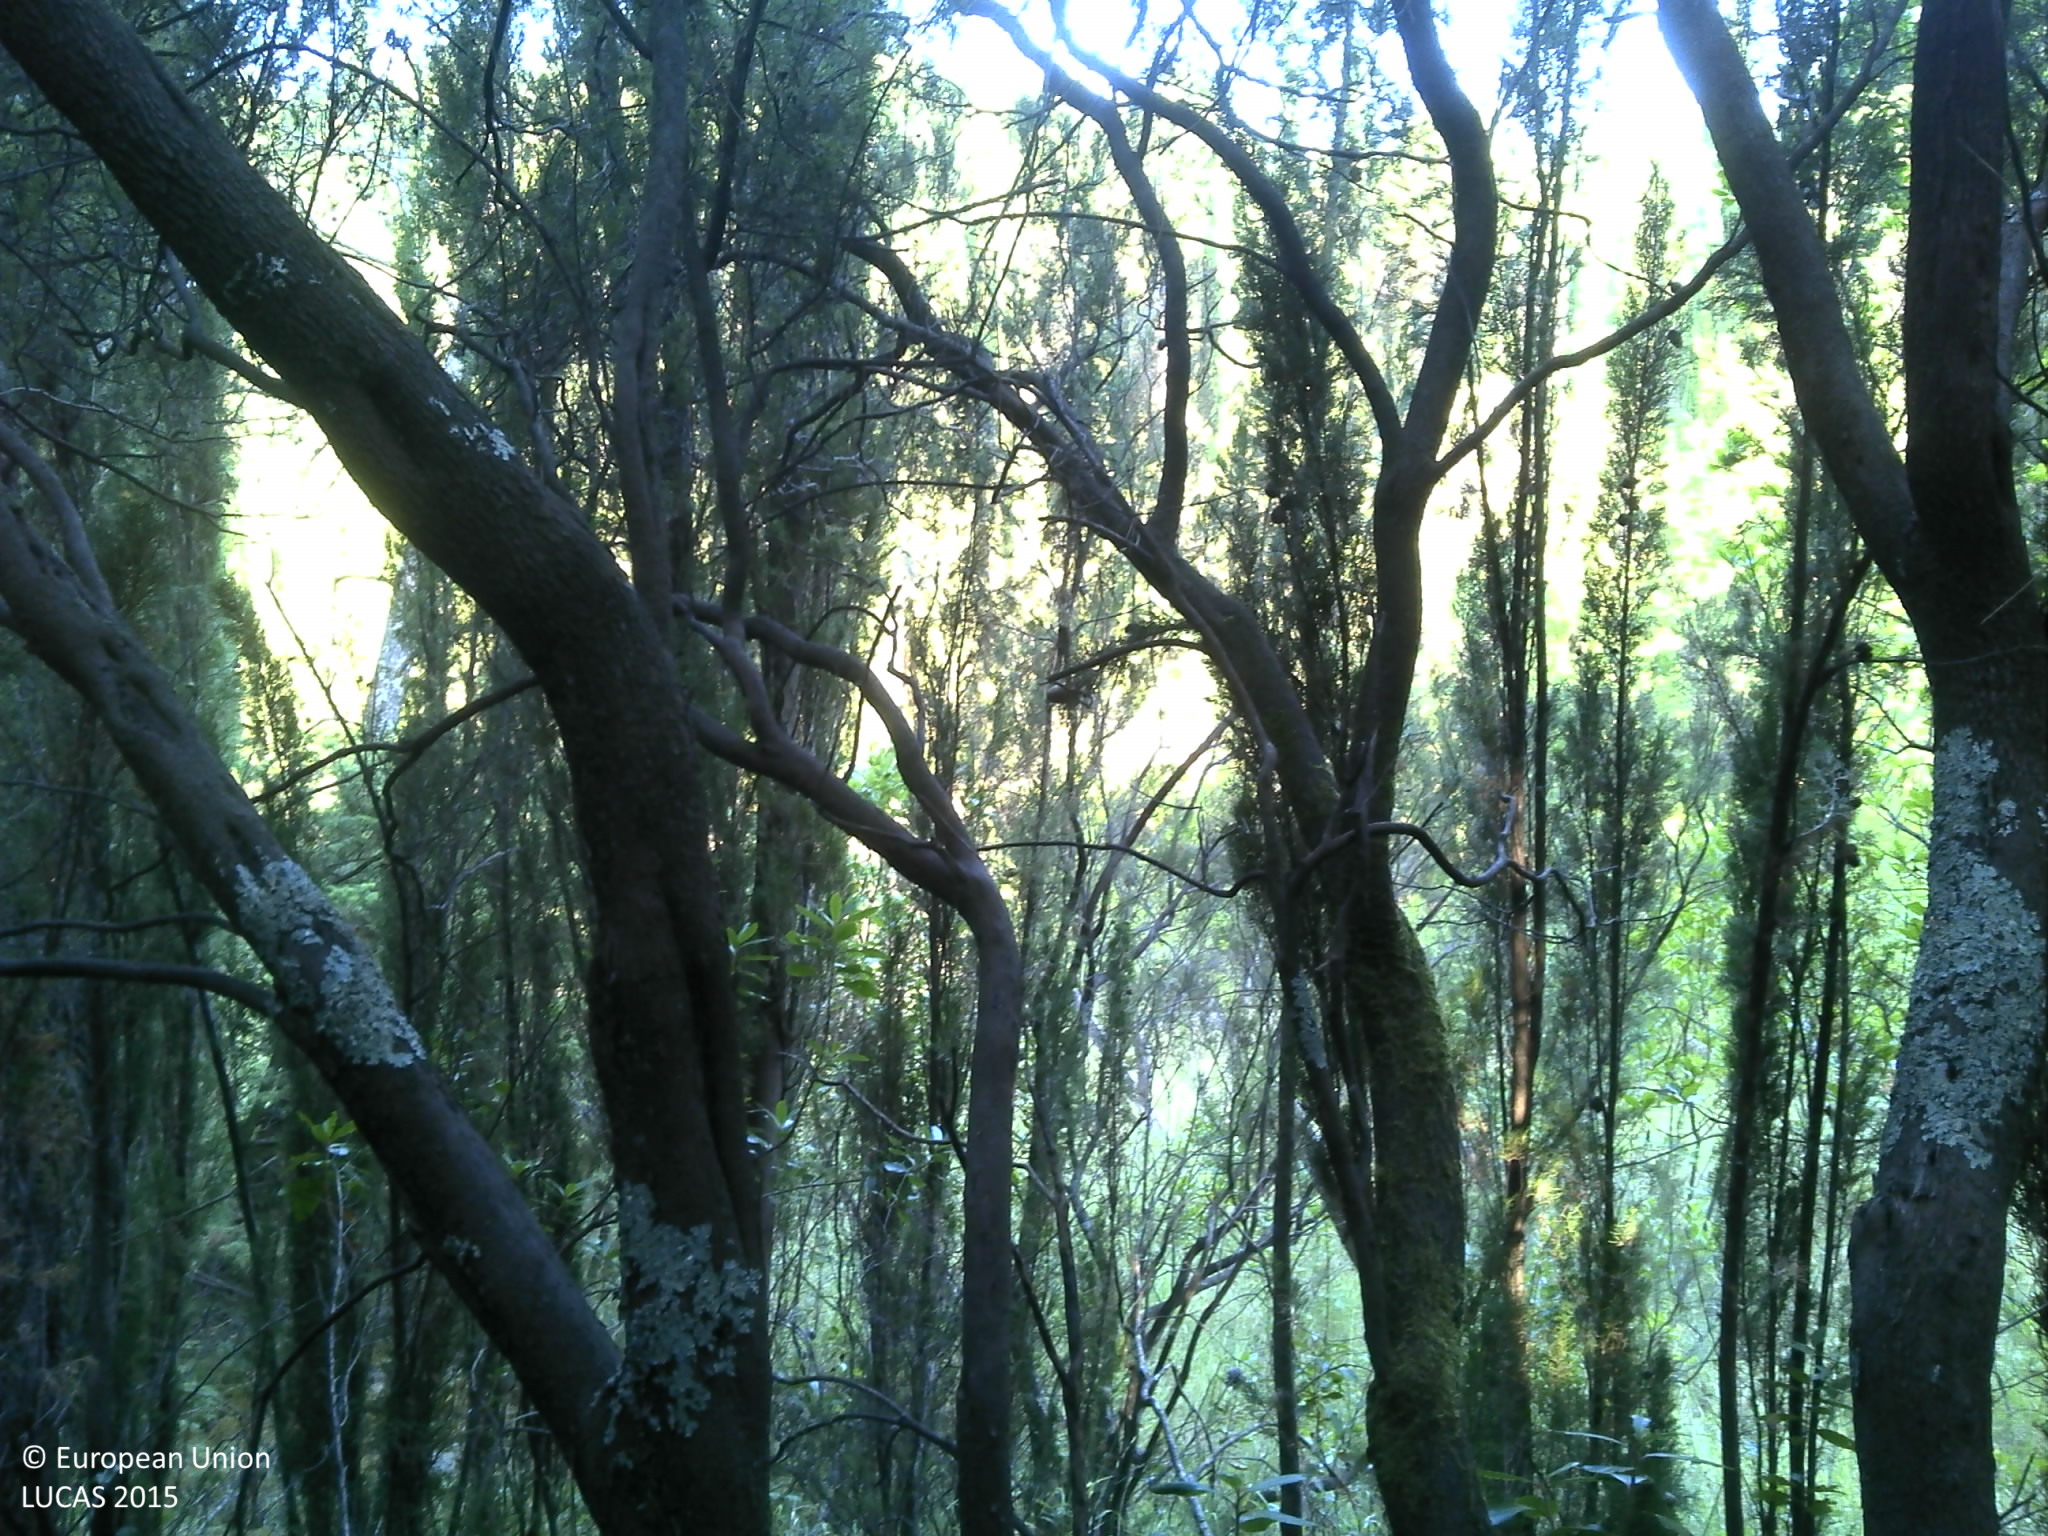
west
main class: Woodland
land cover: Other coniferous woodland
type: coniferous forest of the mediterranean region
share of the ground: > 75 %
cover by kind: coniferous forest trees 80 %, herbaceous plants 10 %, shrubs 5 %, consolidated bare surface 5 %
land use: Semi-natural and natural areas not in use
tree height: > 5 m
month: July
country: HR
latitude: 42.5222
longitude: 18.4019
